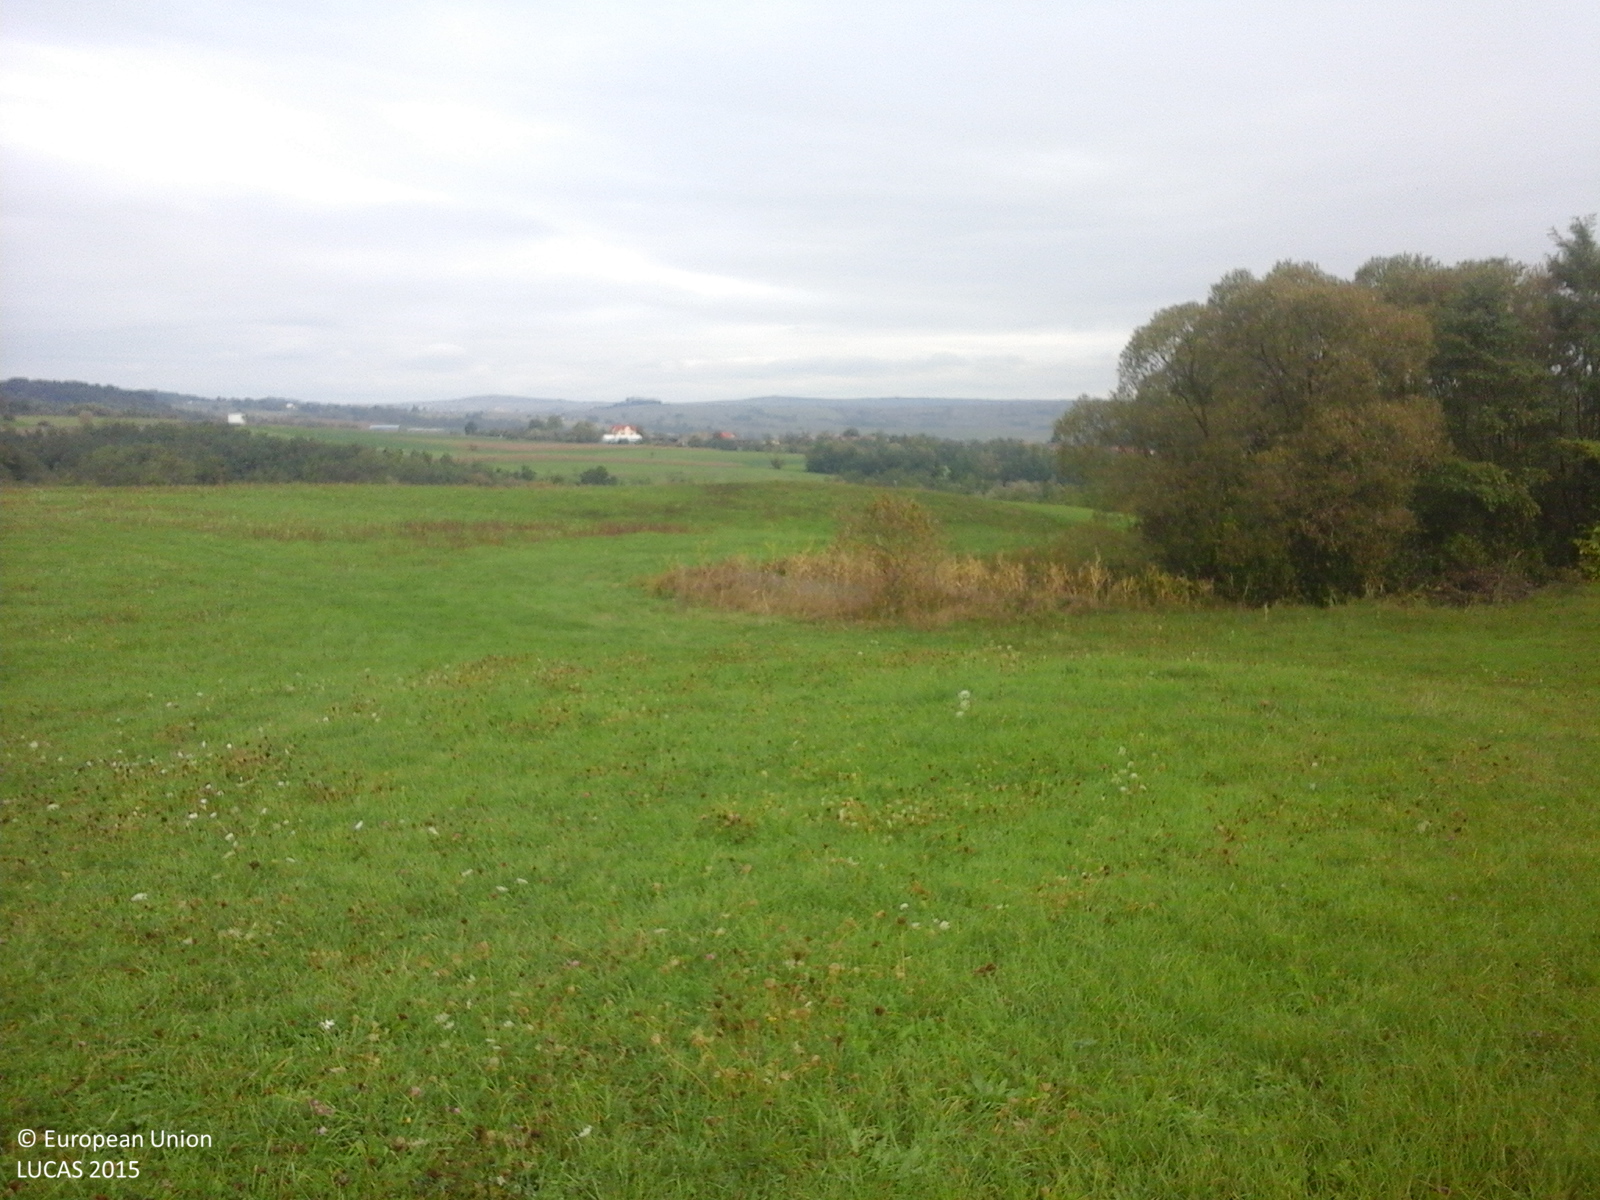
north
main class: Grassland
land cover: Grassland without tree/shrub cover
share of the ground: > 75 %
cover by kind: herbaceous plants 100 %
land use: Agriculture (excluding fallow land and kitchen gardens)
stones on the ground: < 10 %
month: October
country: RO
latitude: 45.9008
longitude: 24.7954
